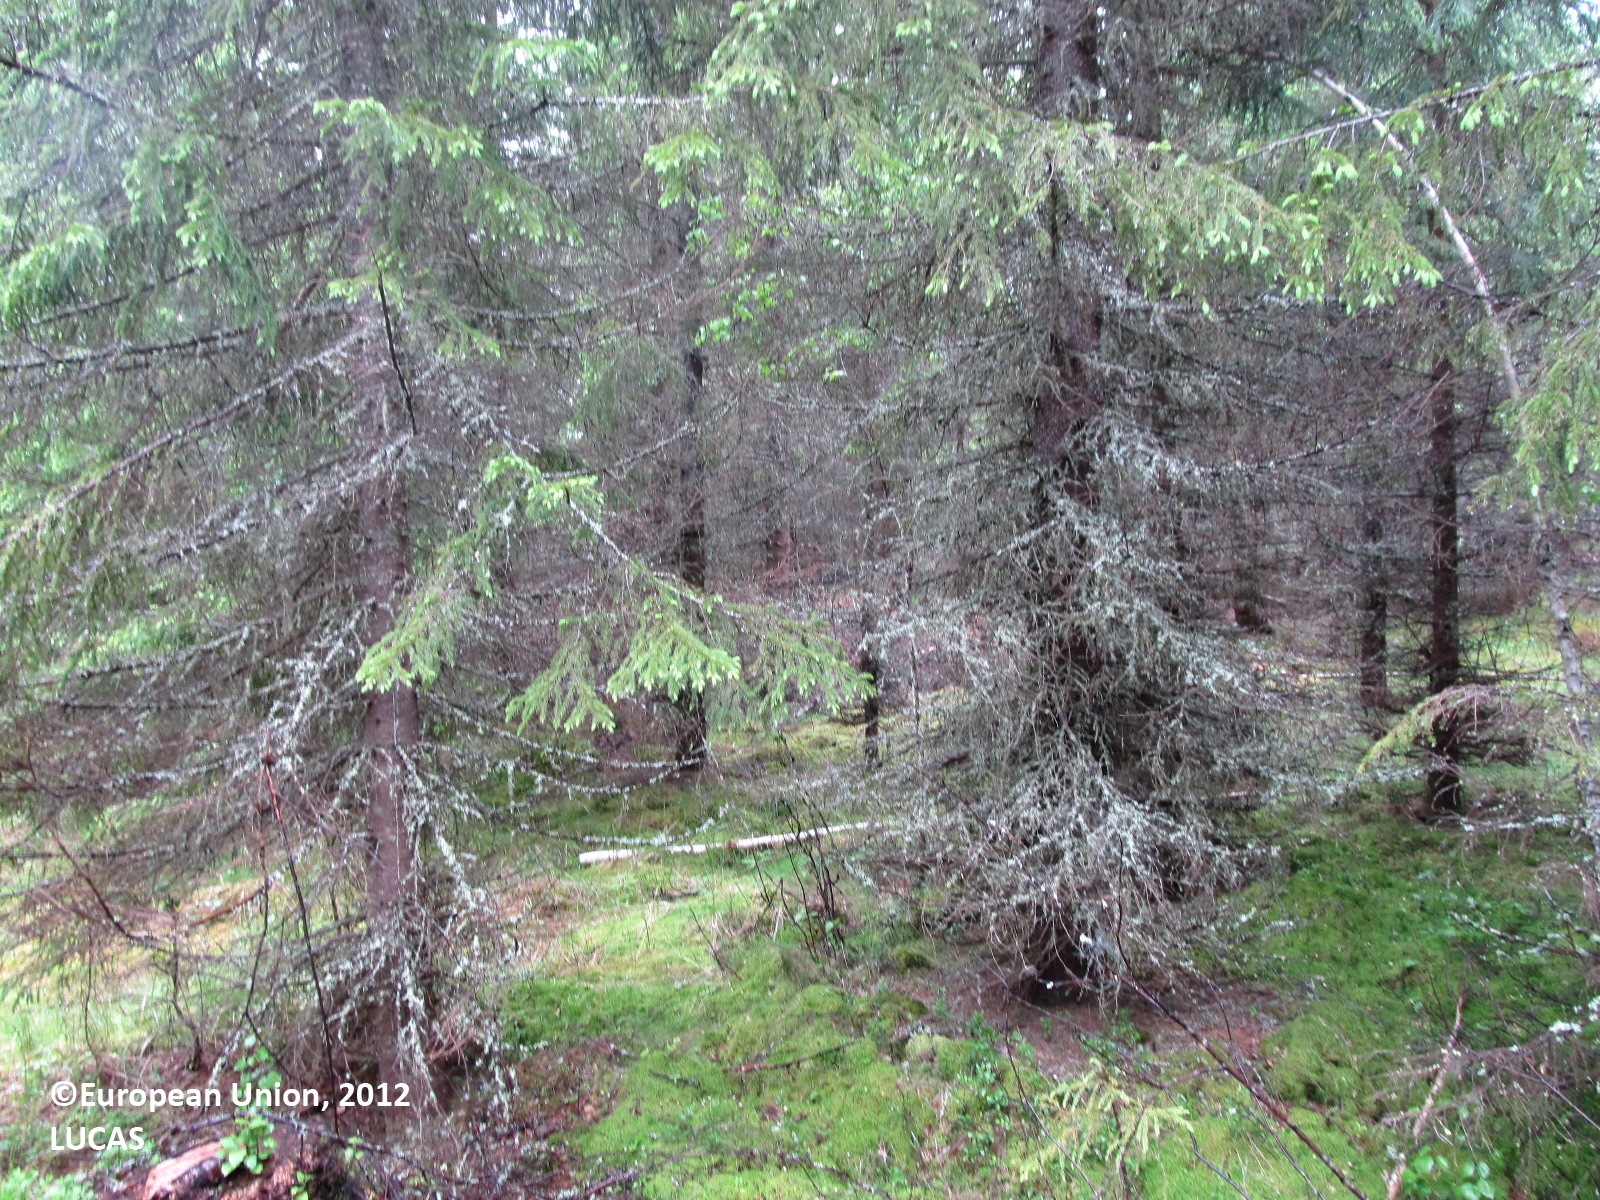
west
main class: Woodland
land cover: Spruce dominated coniferous woodland
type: boreal forest
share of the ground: 25 - 50 %
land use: Forestry
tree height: > 5 m
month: June
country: FI
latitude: 62.8437
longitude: 28.5210
